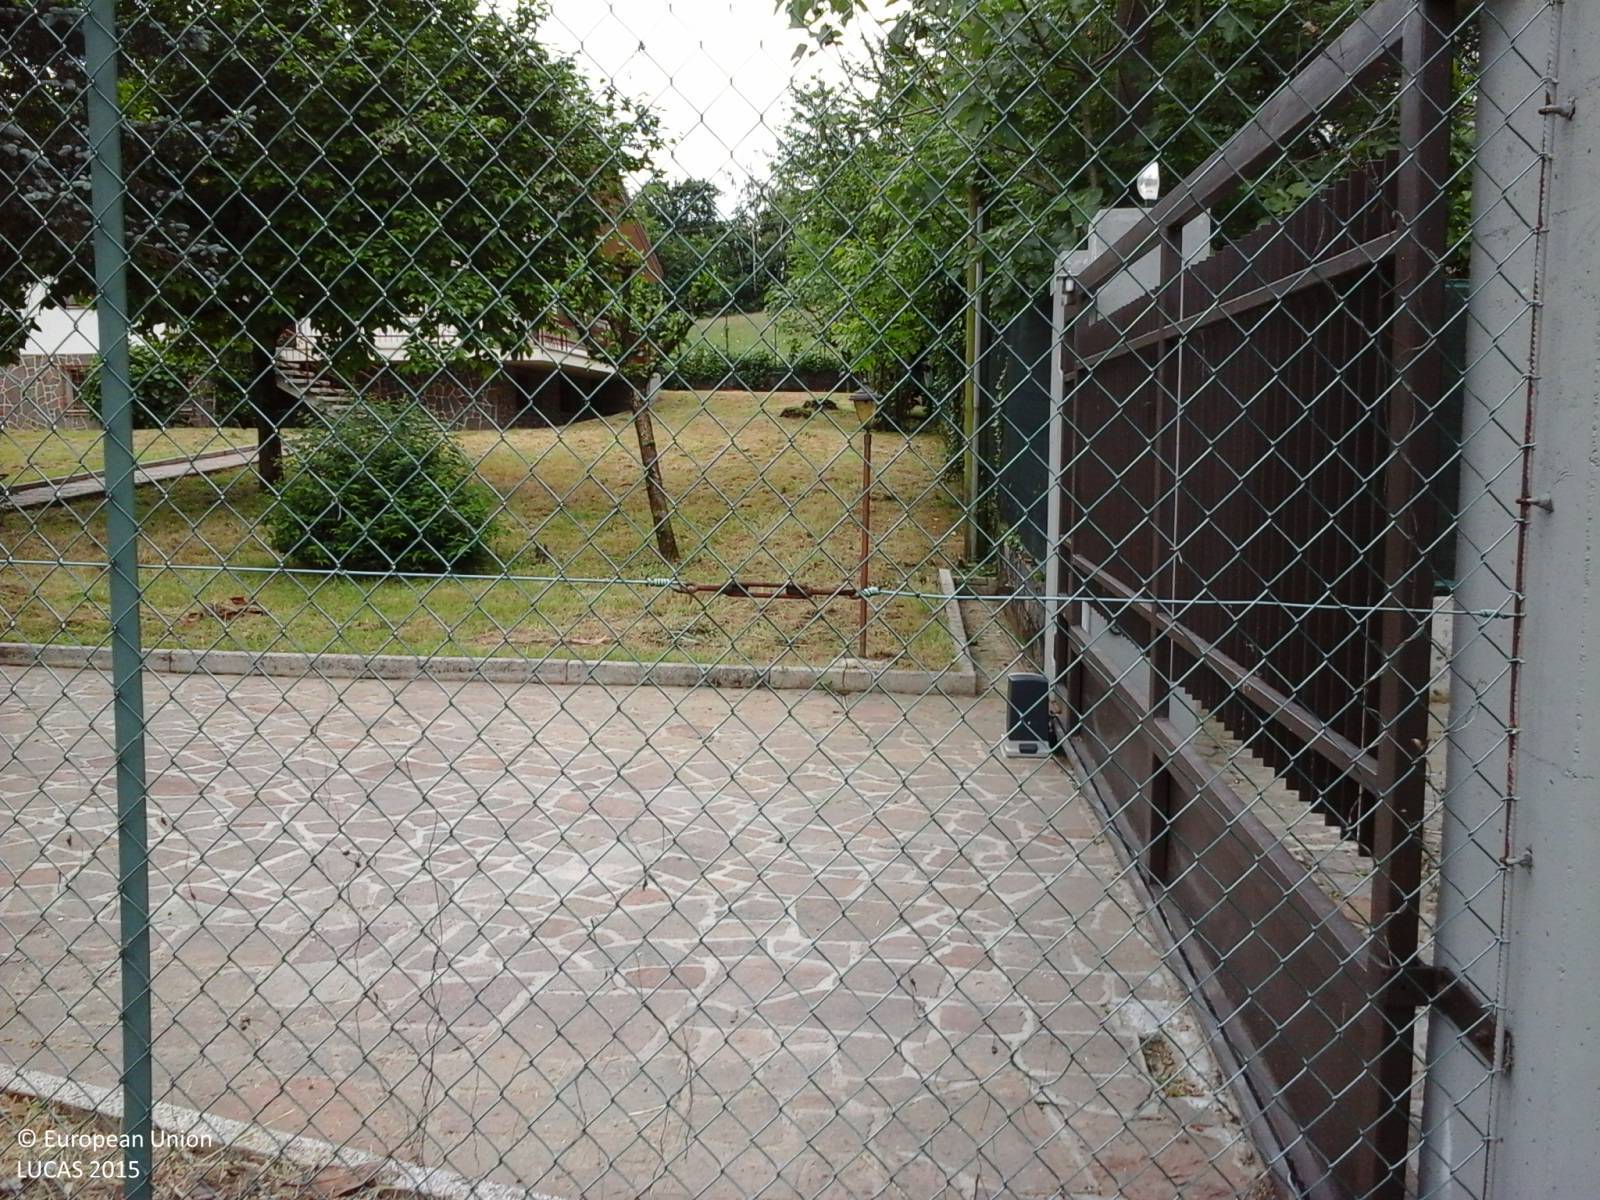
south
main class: Grassland
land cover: Grassland with sparse tree/shrub cover
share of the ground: > 75 %
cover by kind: herbaceous plants 90 %, broadleaved forest trees 5 %, shrubs 5 %
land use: Residential
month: May
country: IT
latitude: 46.1765
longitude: 13.2220
